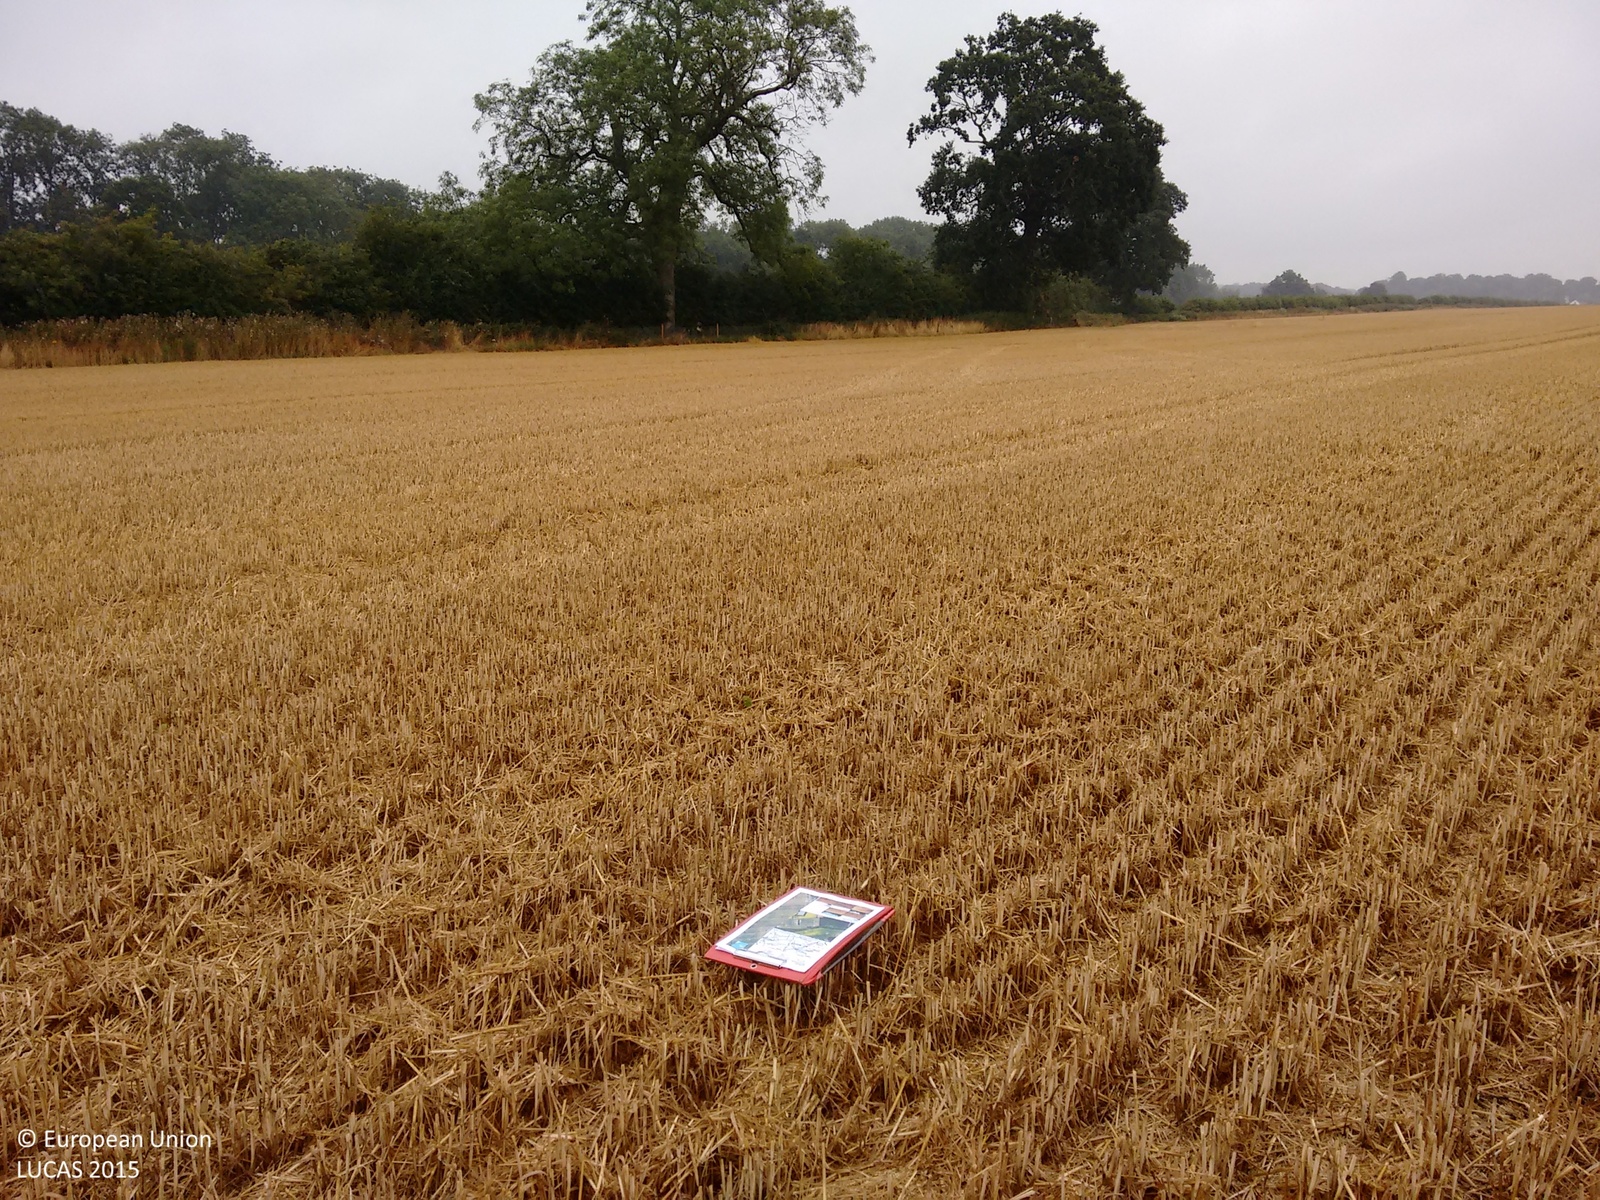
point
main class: Cropland
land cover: Common wheat
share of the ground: > 75 %
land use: Agriculture (excluding fallow land and kitchen gardens)
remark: Harvested field
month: August
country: GB
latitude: 52.7773
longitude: 0.7692
